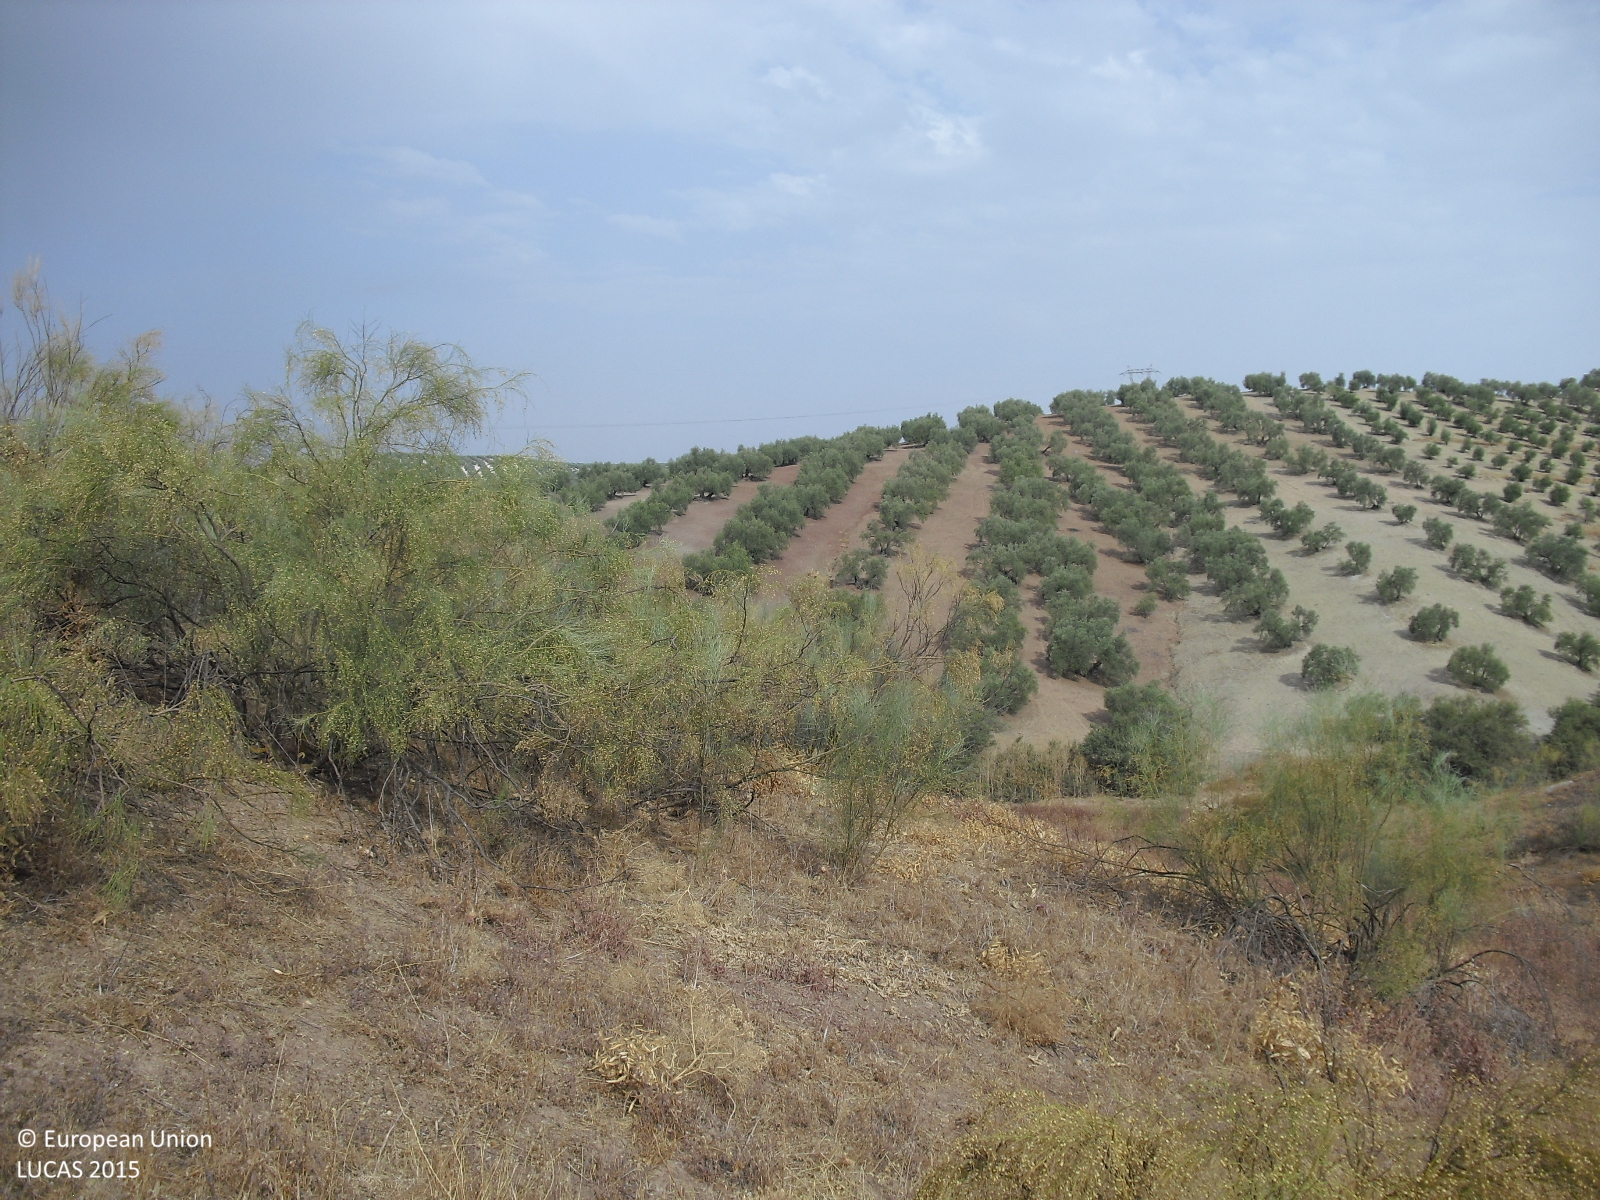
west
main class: Shrubland
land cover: Shrubland without tree cover
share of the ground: 10 - 25 %
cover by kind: herbaceous plants 75 %, shrubs 15 %, unconsolidated bare surface 10 %
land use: Semi-natural and natural areas not in use
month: August
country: ES
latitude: 37.3205
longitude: -4.4334
